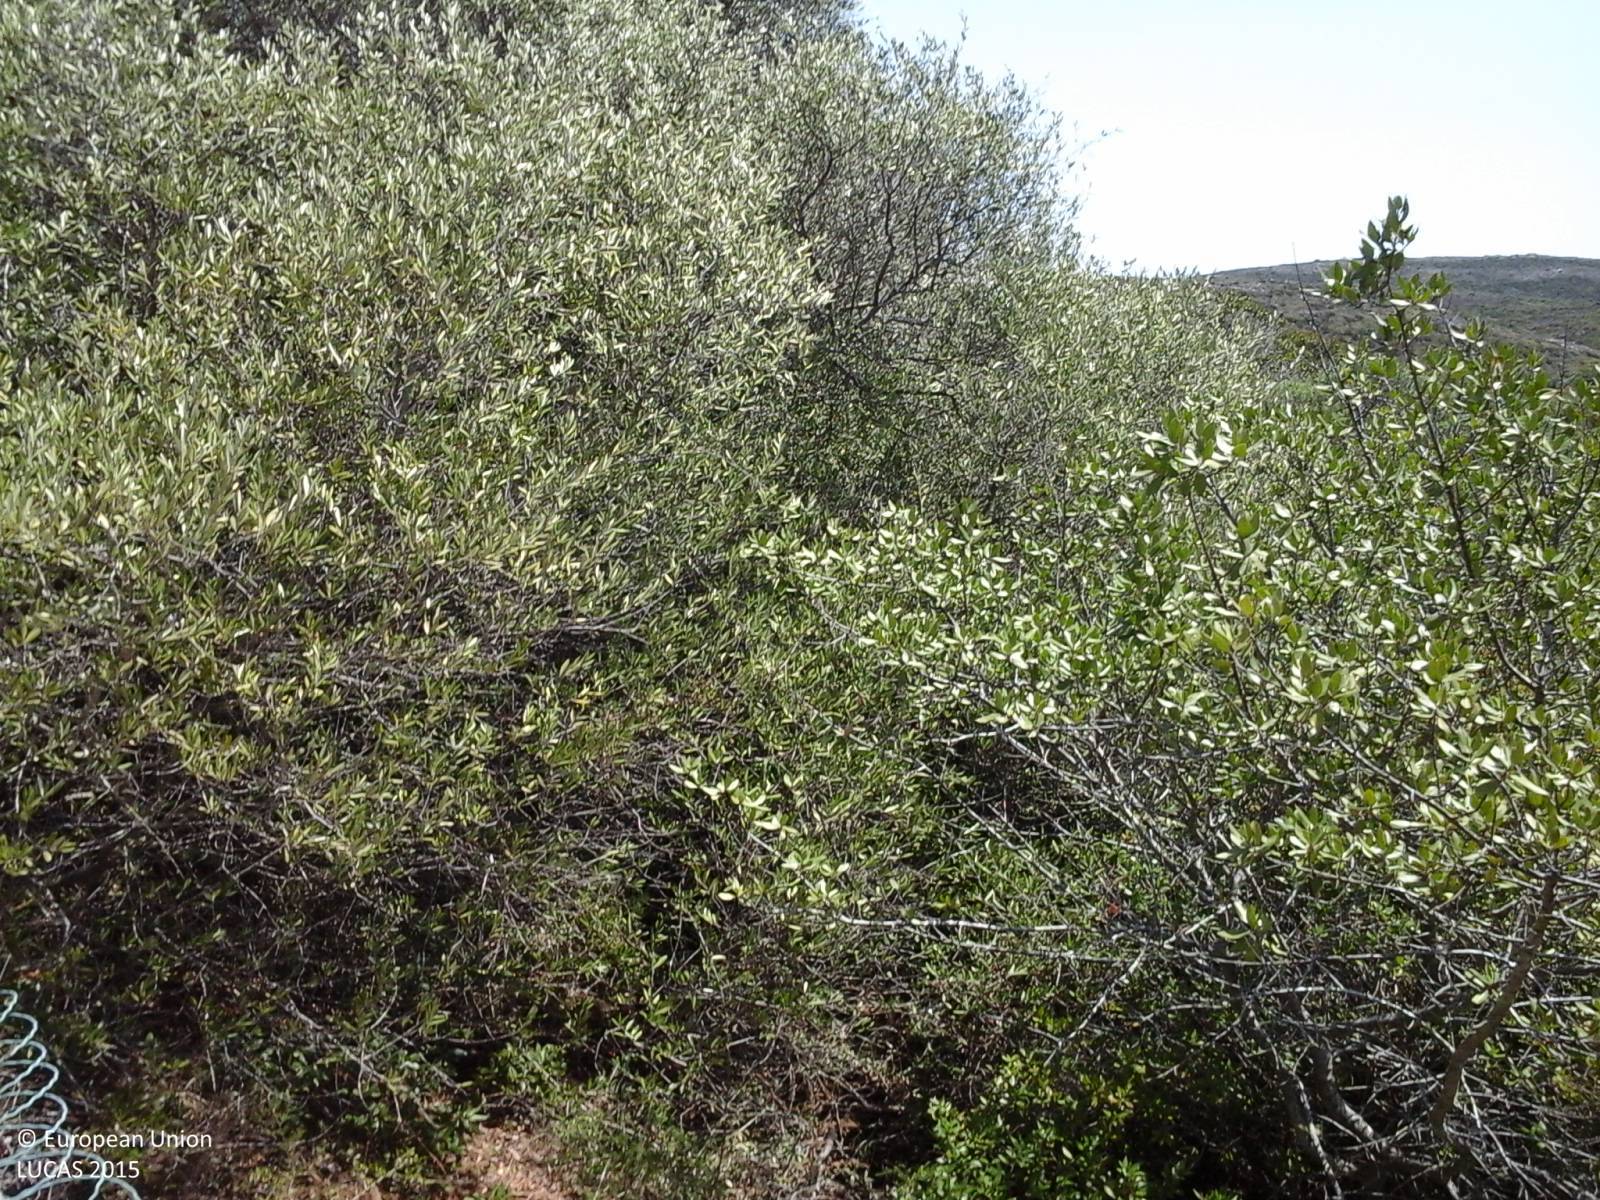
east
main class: Shrubland
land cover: Shrubland with sparse tree cover
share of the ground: > 75 %
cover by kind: shrubs 60 %, herbaceous plants 35 %, broadleaved forest trees 5 %
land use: Semi-natural and natural areas not in use
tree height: > 5 m
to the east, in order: Shrubland with sparse tree cover; Rocks and stones; Shrubland with sparse tree cover; Grassland without tree/shrub cover; Shrubland without tree cover
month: July
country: IT
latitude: 41.2414
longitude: 9.2278
